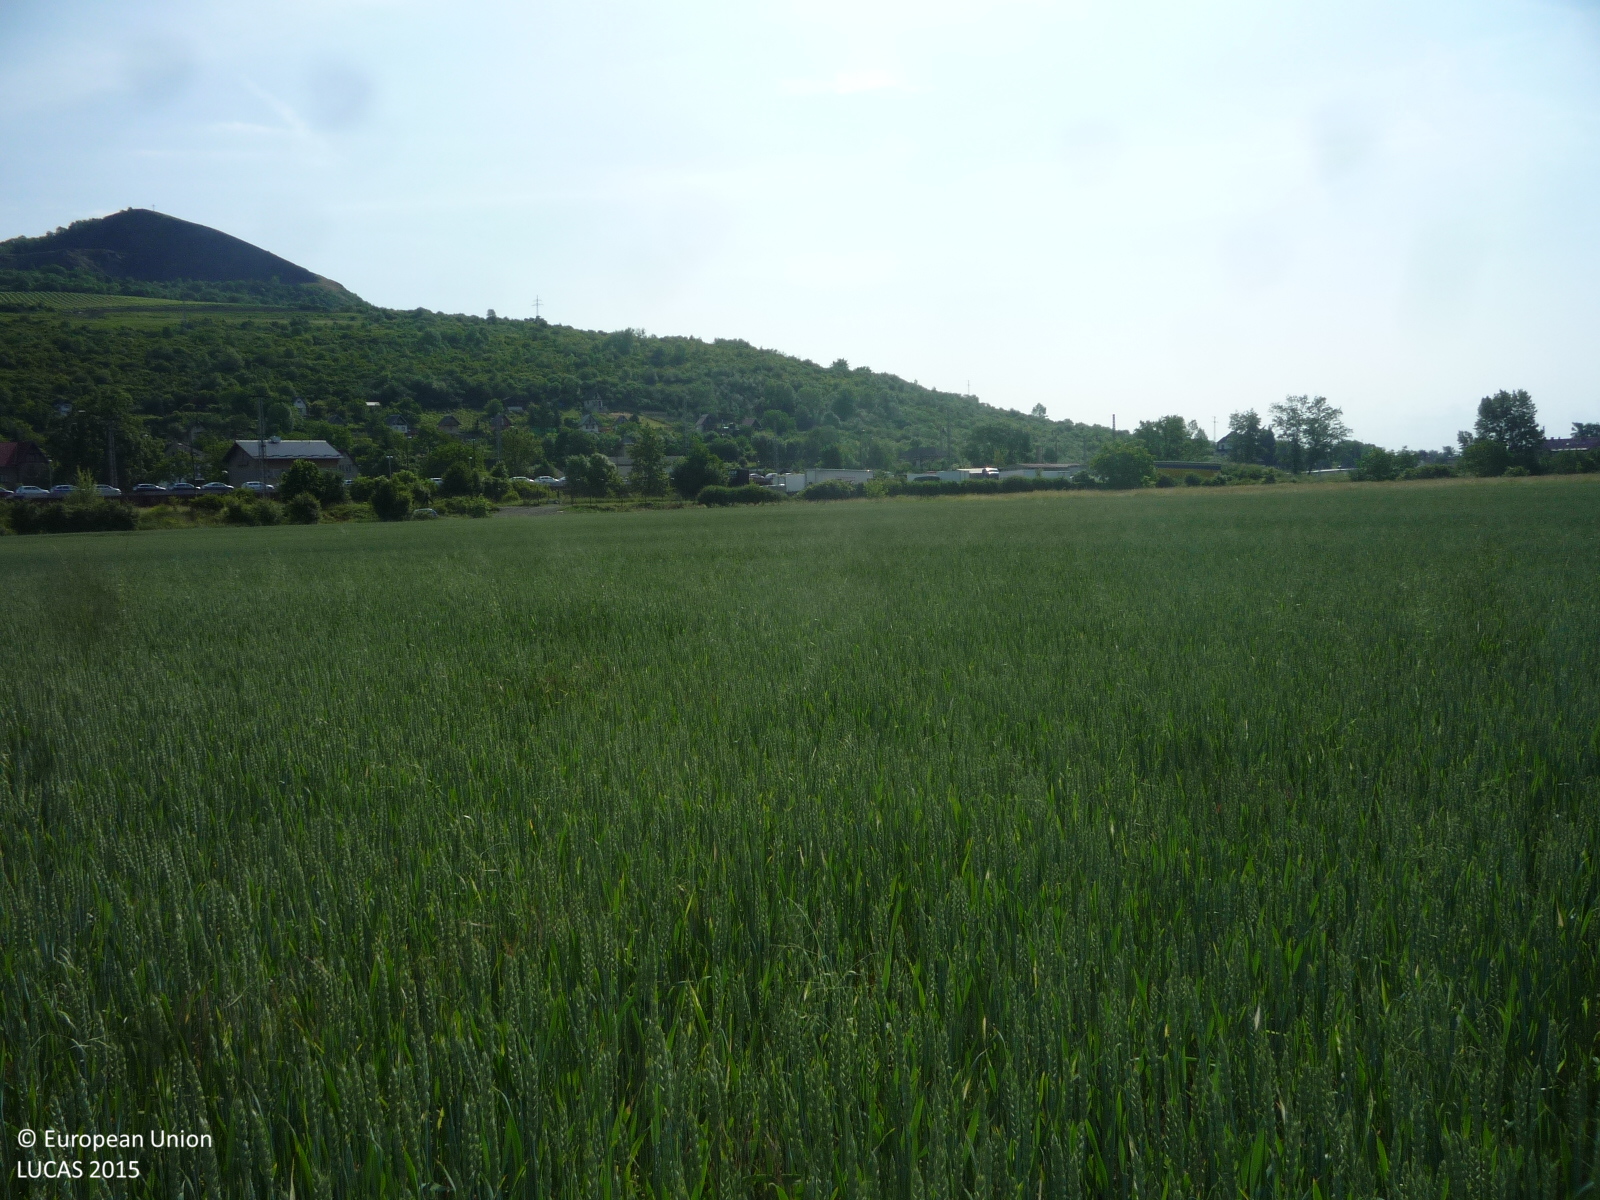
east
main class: Cropland
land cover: Common wheat
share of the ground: > 75 %
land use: Agriculture (excluding fallow land and kitchen gardens)
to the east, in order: Common wheat; Grassland with sparse tree/shrub cover; Paved roads, cycling and walking lanes; Grass margins; Artificial constructions in urban areas
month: June
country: CZ
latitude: 50.5254
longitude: 14.0777
